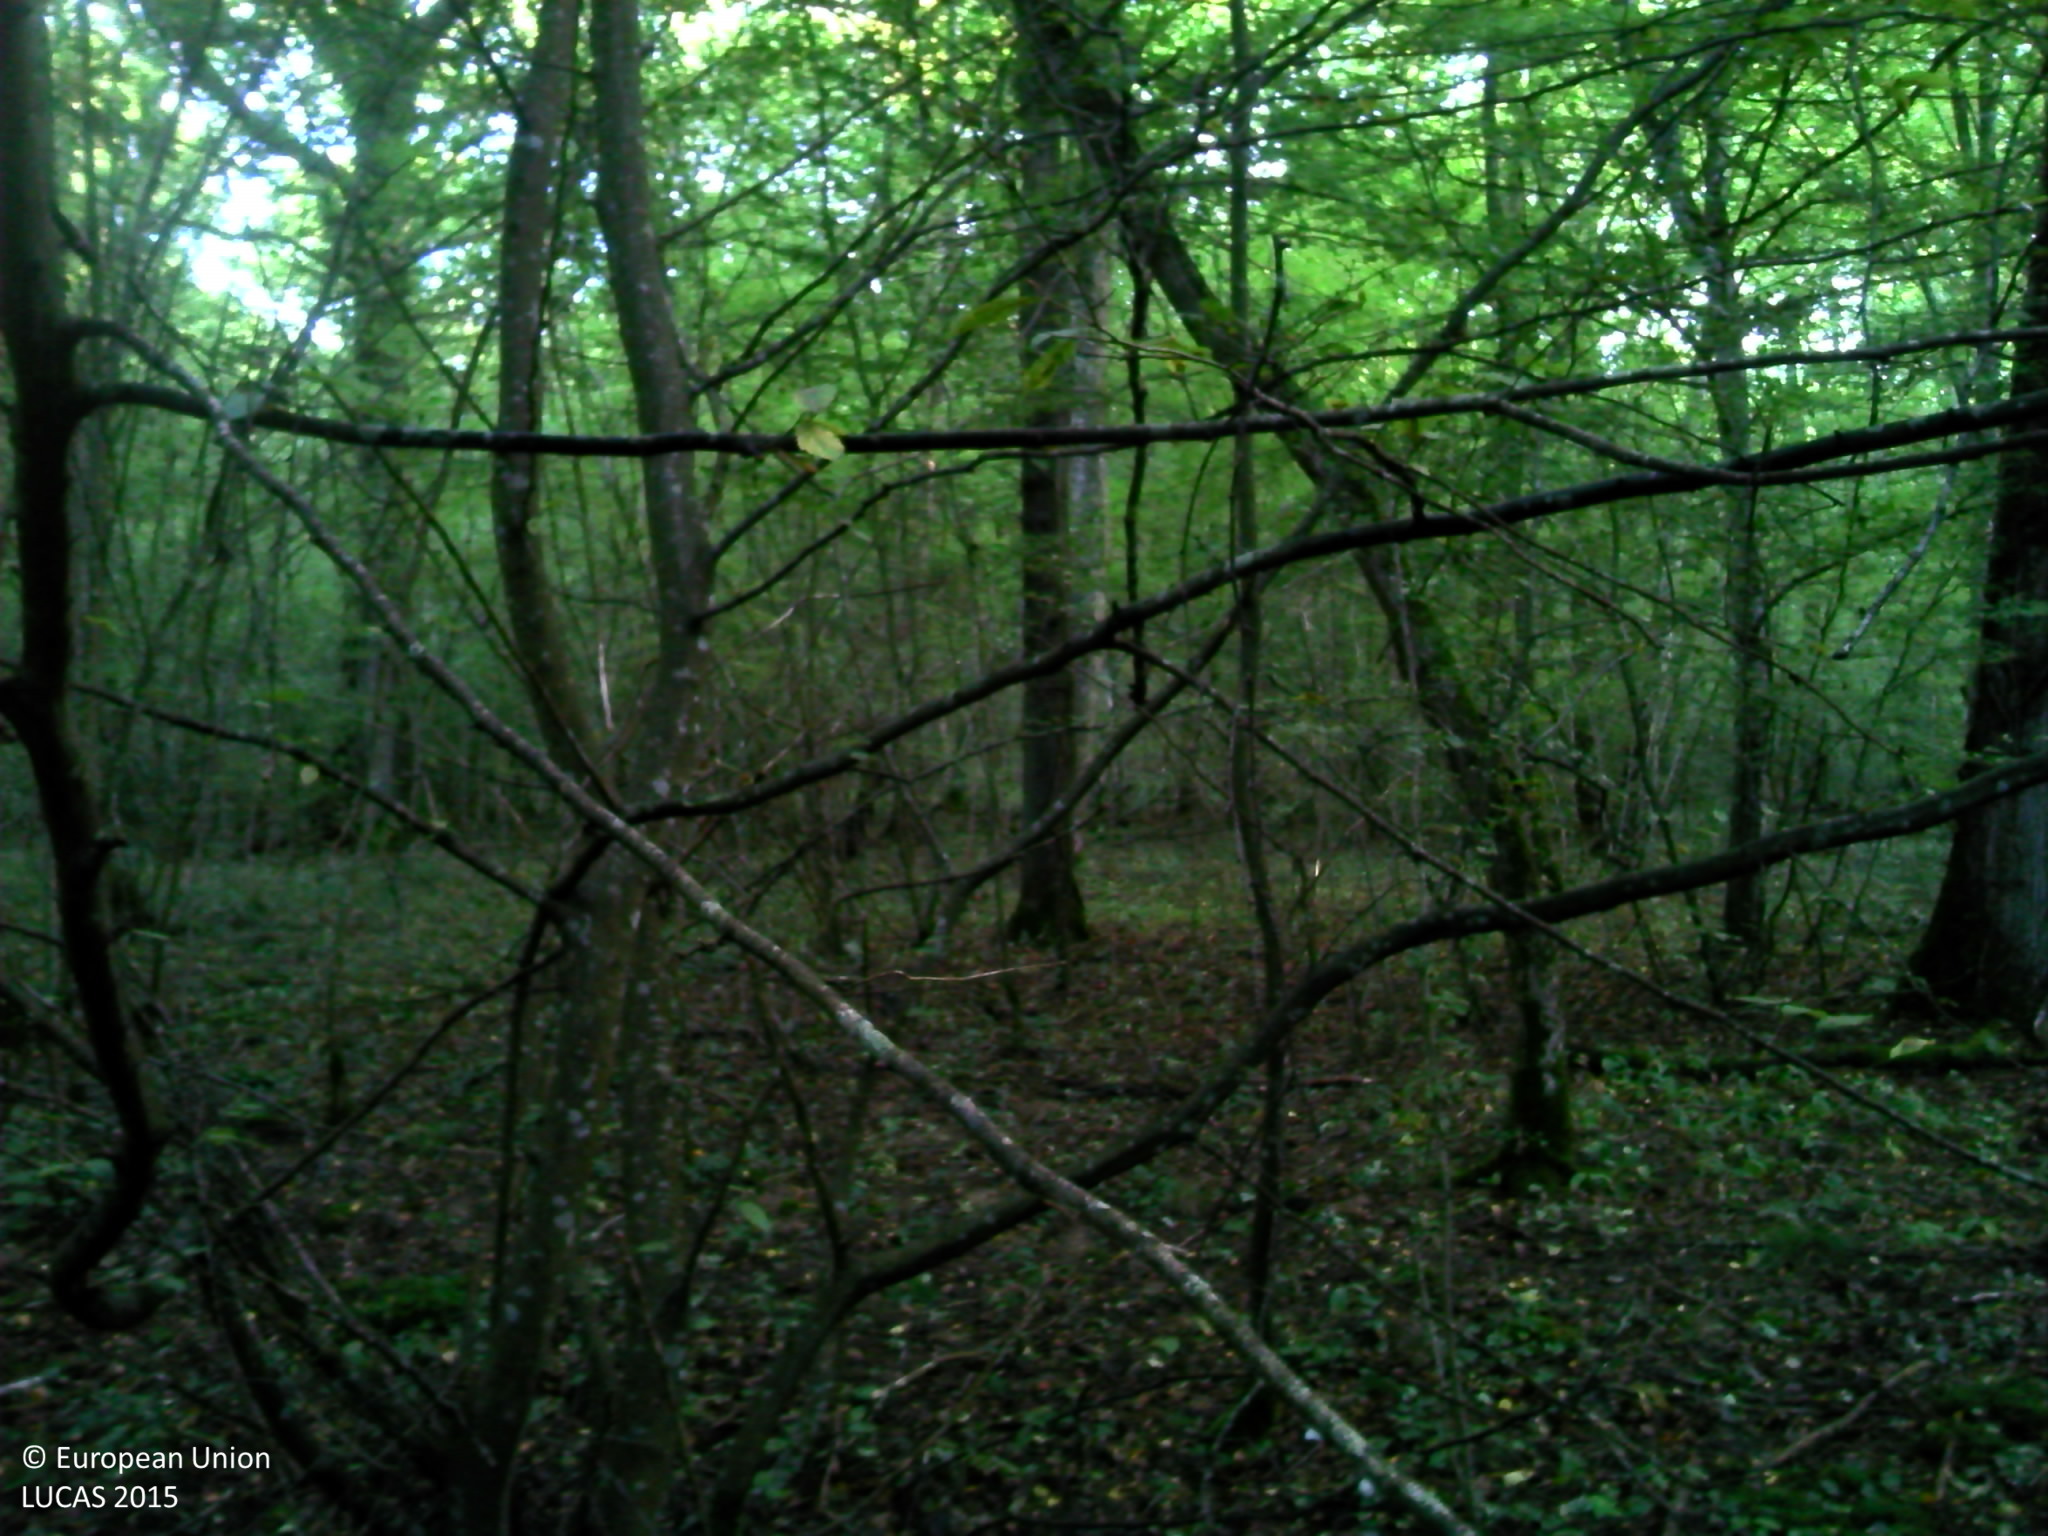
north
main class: Woodland
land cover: Broadleaved woodland
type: mesophytic deciduous forest
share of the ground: > 75 %
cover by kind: broadleaved forest trees 95 %, herbaceous plants 5 %
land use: Forestry
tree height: > 5 m
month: September
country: FR
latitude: 47.0611
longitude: 4.9319
